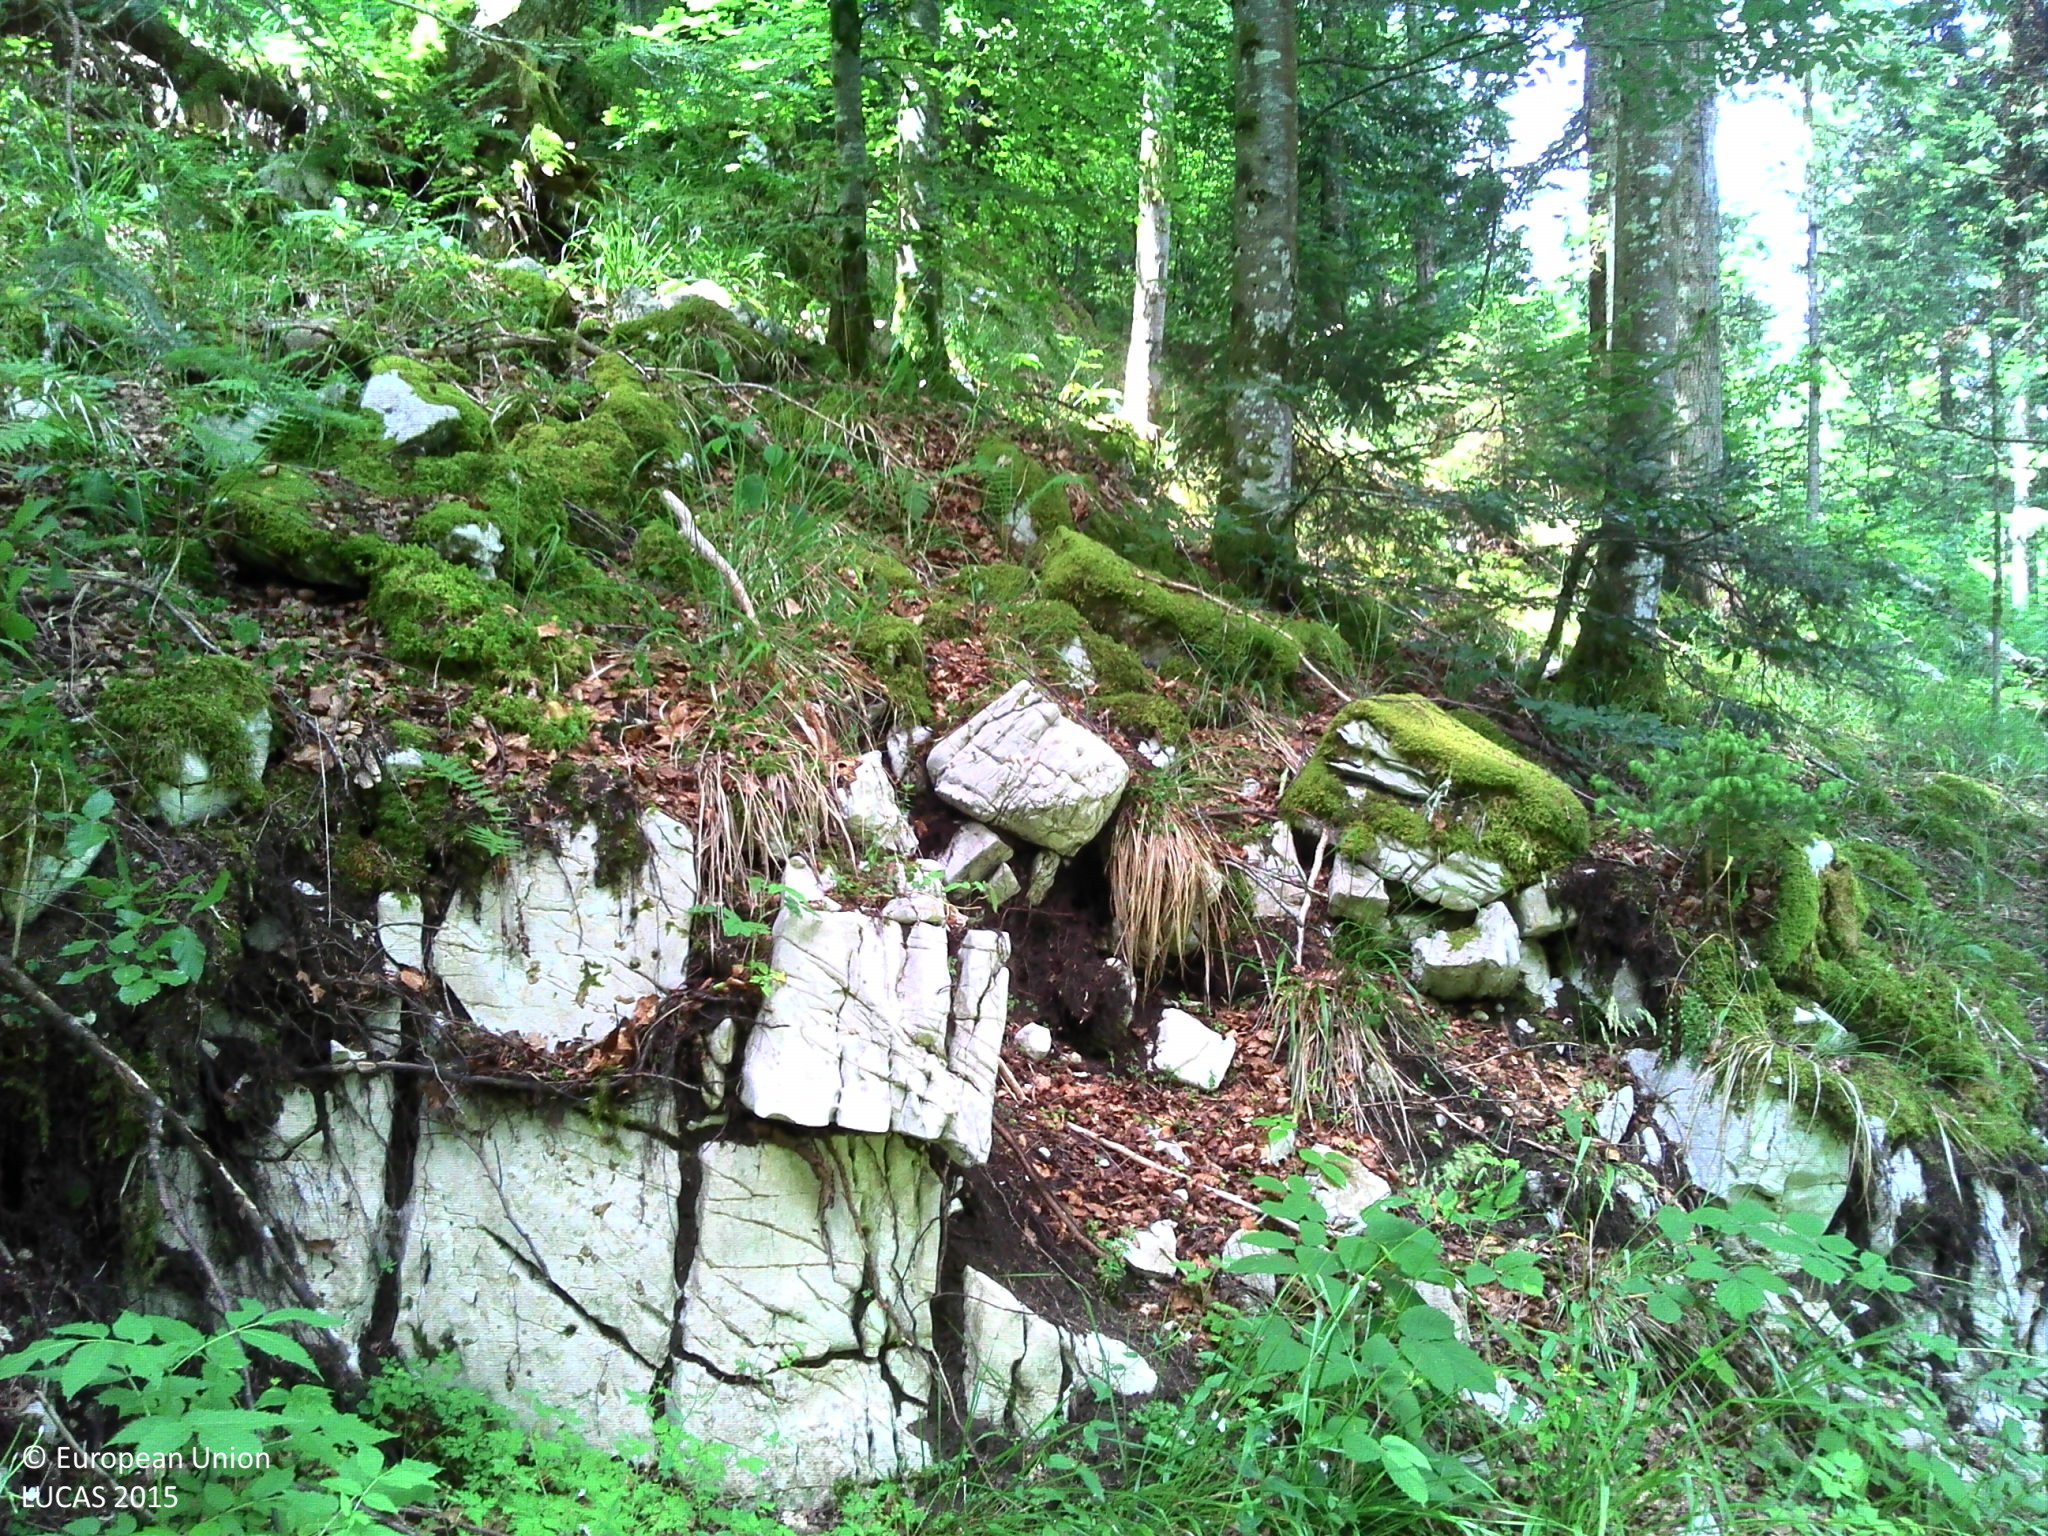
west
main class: Woodland
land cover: Spruce dominated mixed woodland
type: mountainous beech forest
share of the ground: > 75 %
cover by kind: coniferous forest trees 30 %, broadleaved forest trees 30 %, shrubs 10 %, herbaceous plants 10 %, lichens and mosses 10 %, consolidated bare surface 10 %
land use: Forestry
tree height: > 5 m
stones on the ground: > 50 %
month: July
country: FR
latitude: 46.7324
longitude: 6.1422
